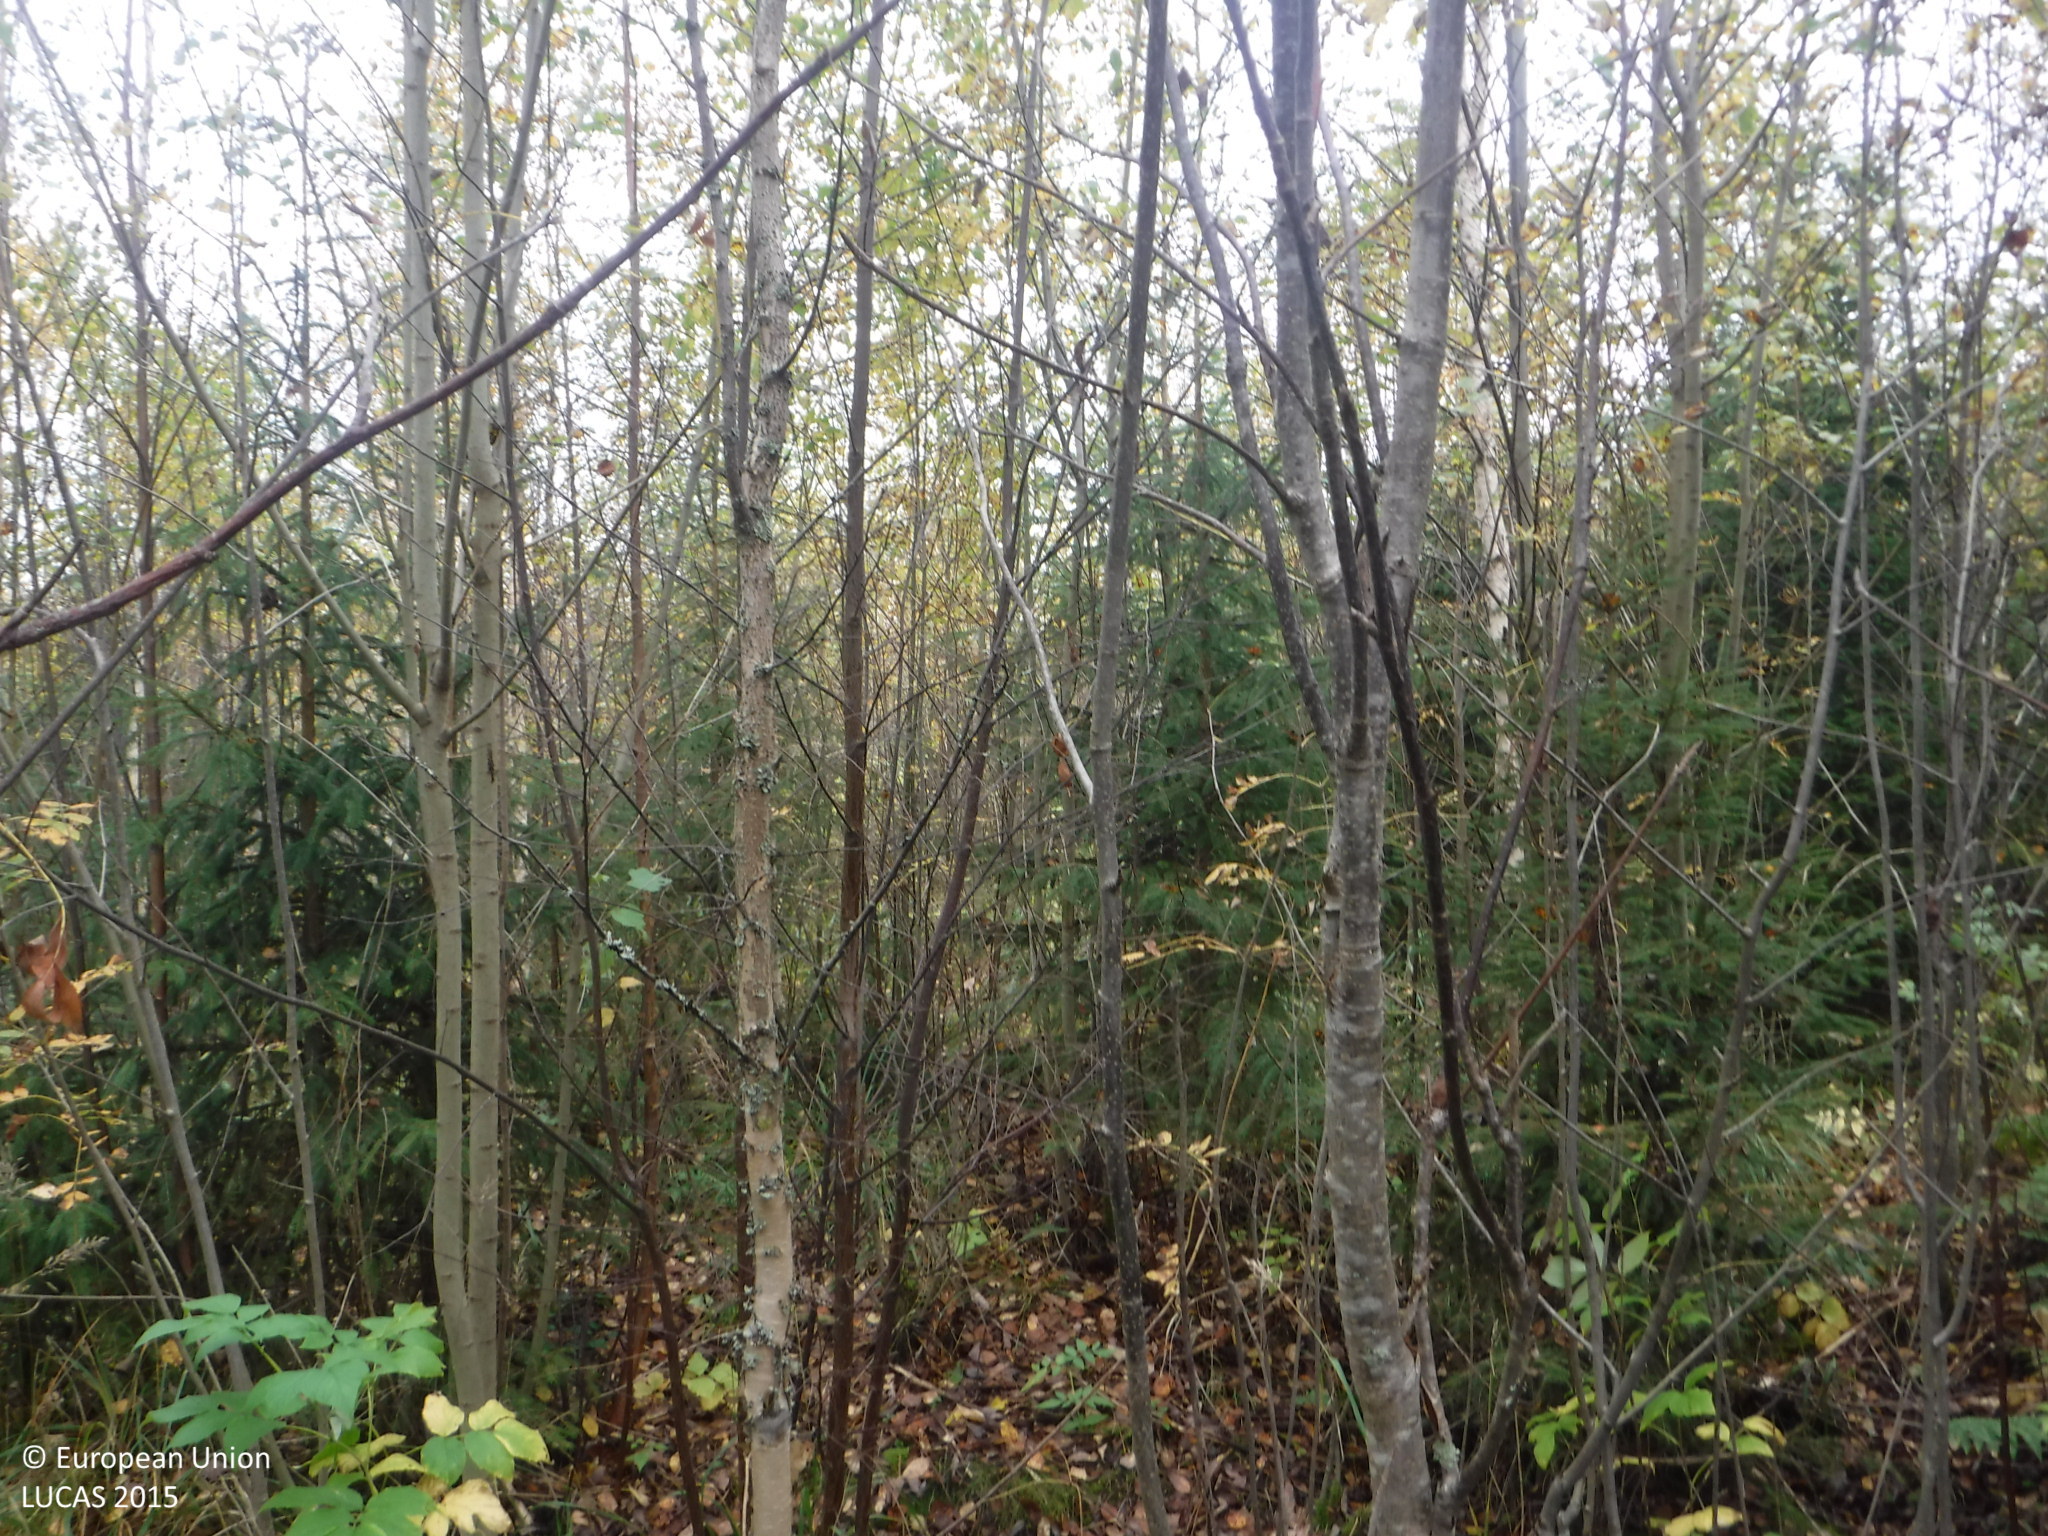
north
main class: Woodland
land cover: Broadleaved woodland
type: boreal forest
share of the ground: > 75 %
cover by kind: broadleaved forest trees 75 %, coniferous forest trees 10 %, lichens and mosses 10 %, shrubs 5 %
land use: Forestry
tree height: > 5 m
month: September
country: FI
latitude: 61.7405
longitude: 24.1182
